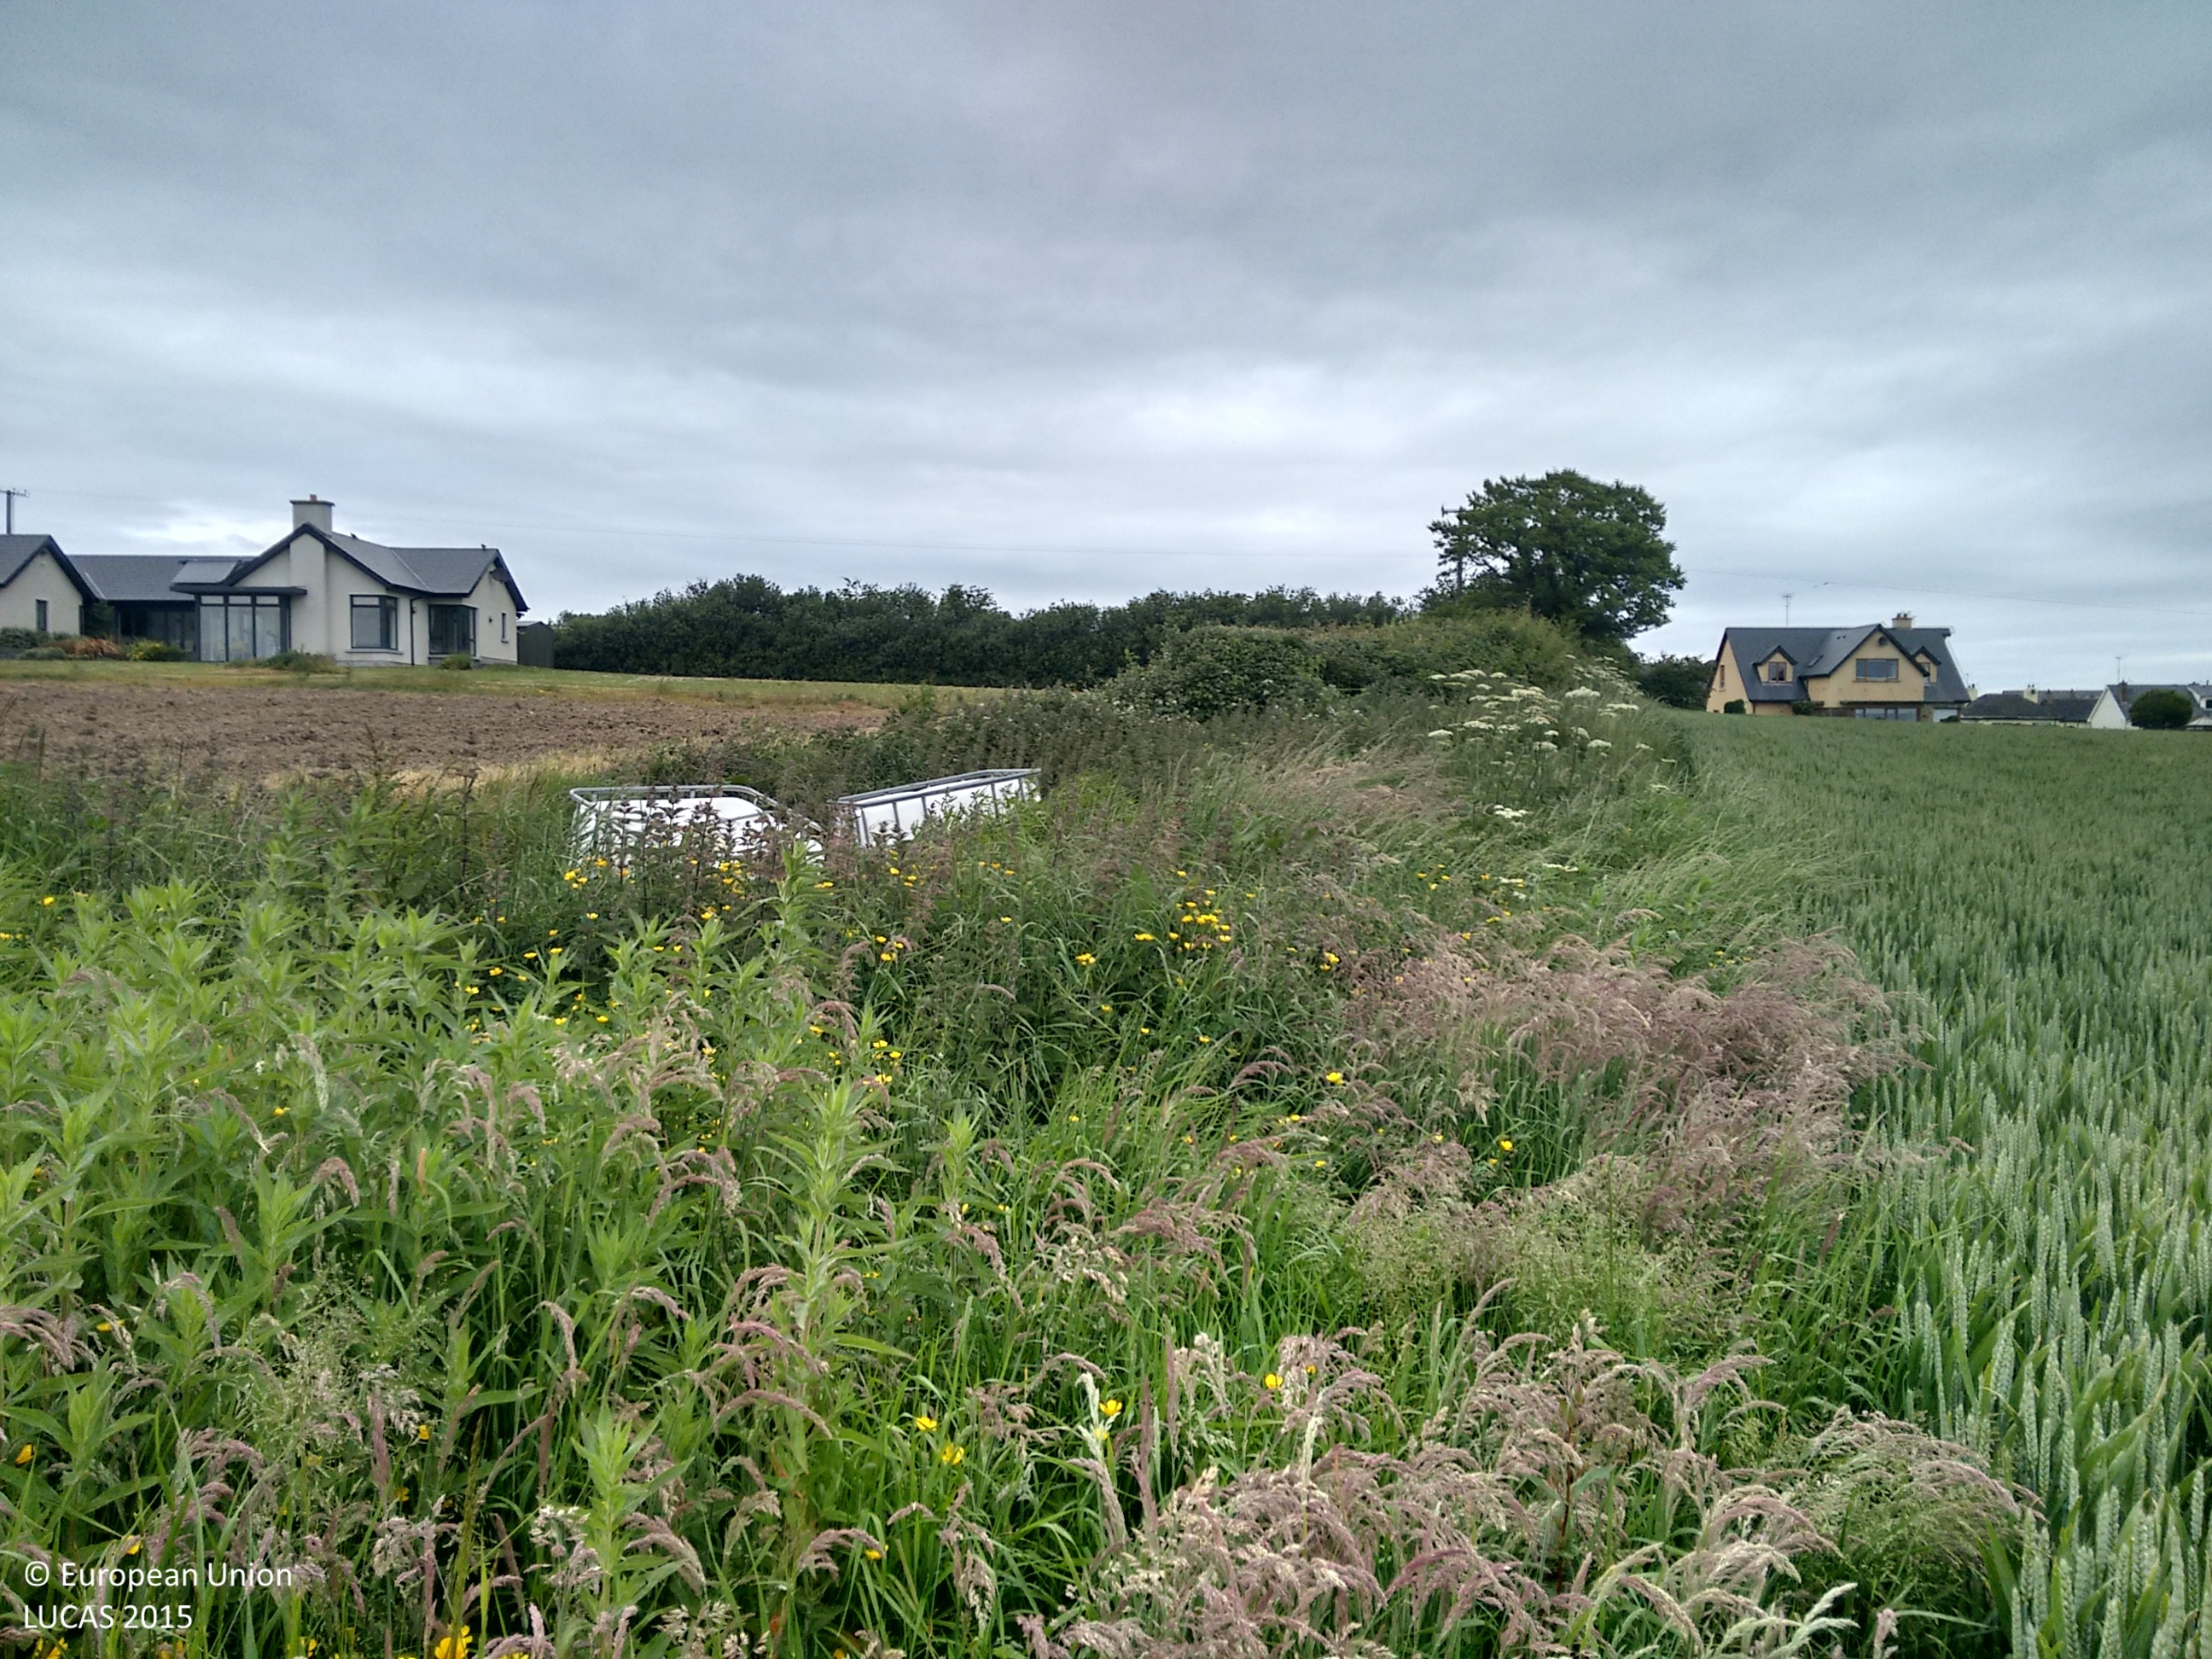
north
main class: Cropland
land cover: Barley
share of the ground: > 75 %
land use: Agriculture (excluding fallow land and kitchen gardens)
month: June
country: IE
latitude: 53.5448
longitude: -6.0967
